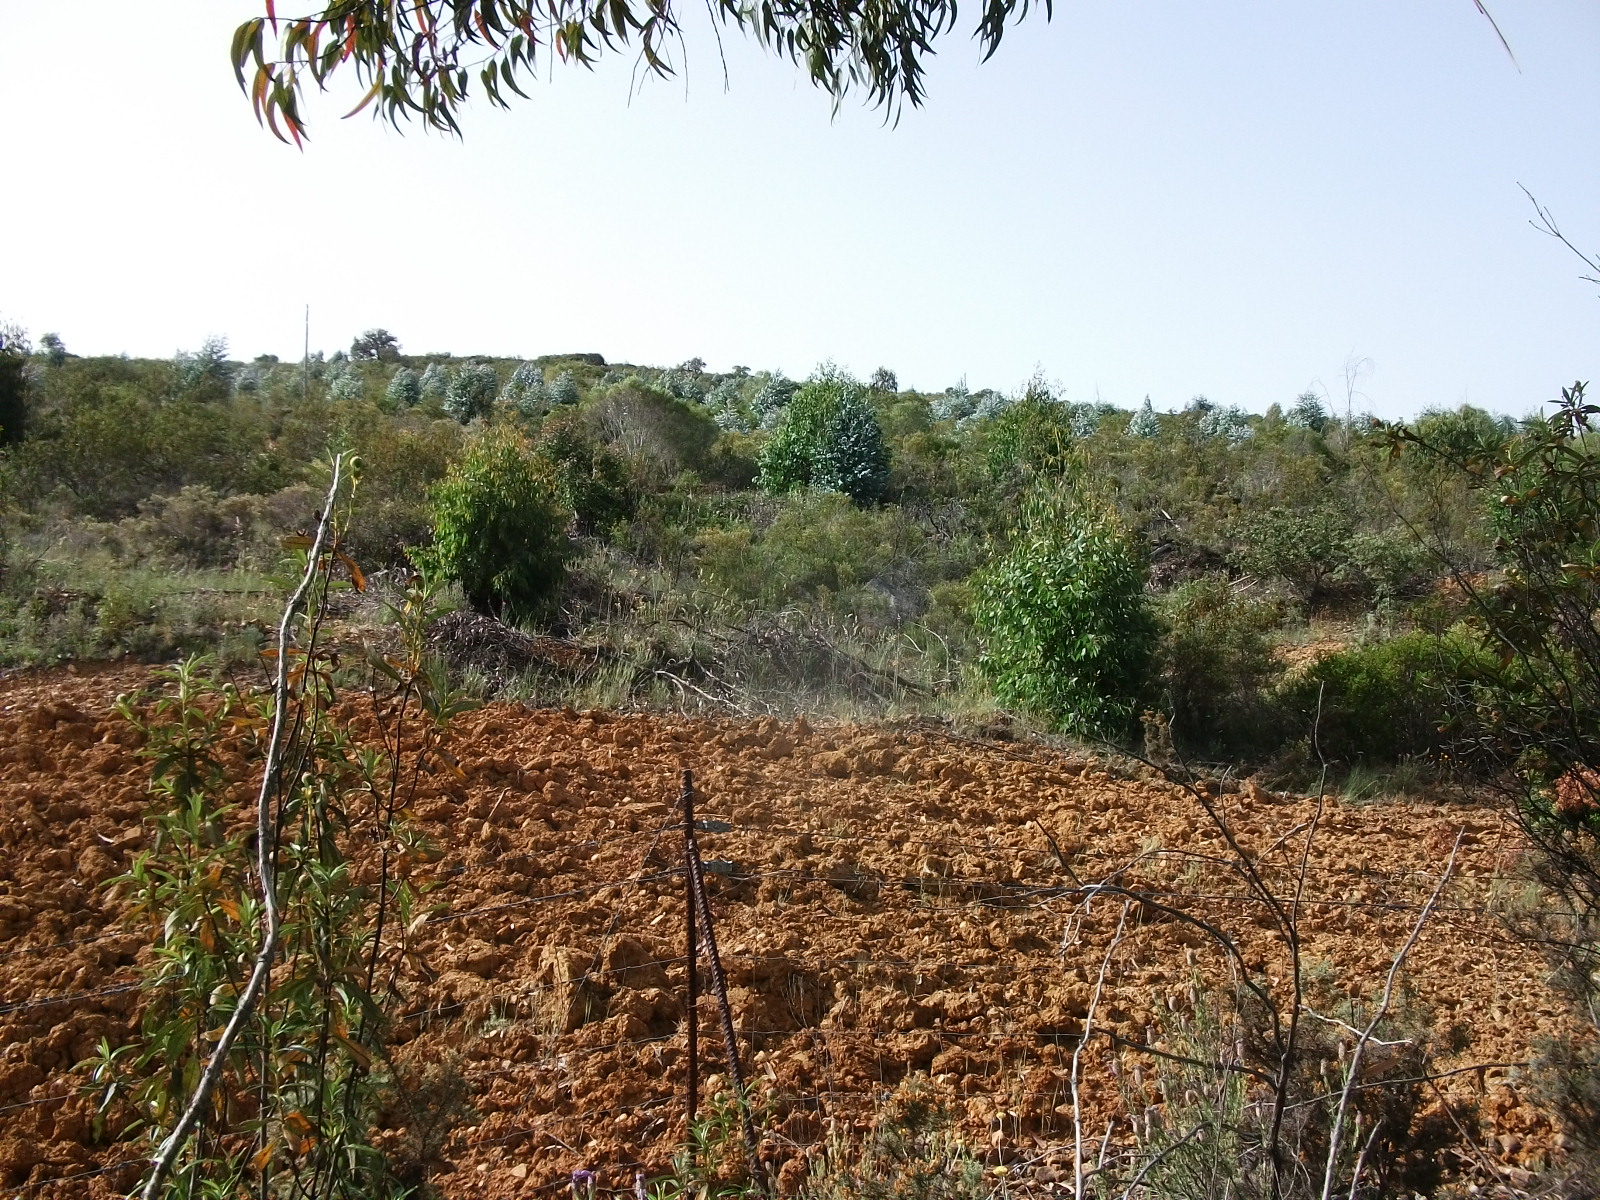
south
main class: Woodland
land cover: Broadleaved woodland
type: exotic forest
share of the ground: 25 - 50 %
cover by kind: shrubs 70 %, broadleaved forest trees 30 %
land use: Forestry
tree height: > 5 m
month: May
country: ES
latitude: 37.7709
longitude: -7.0223
